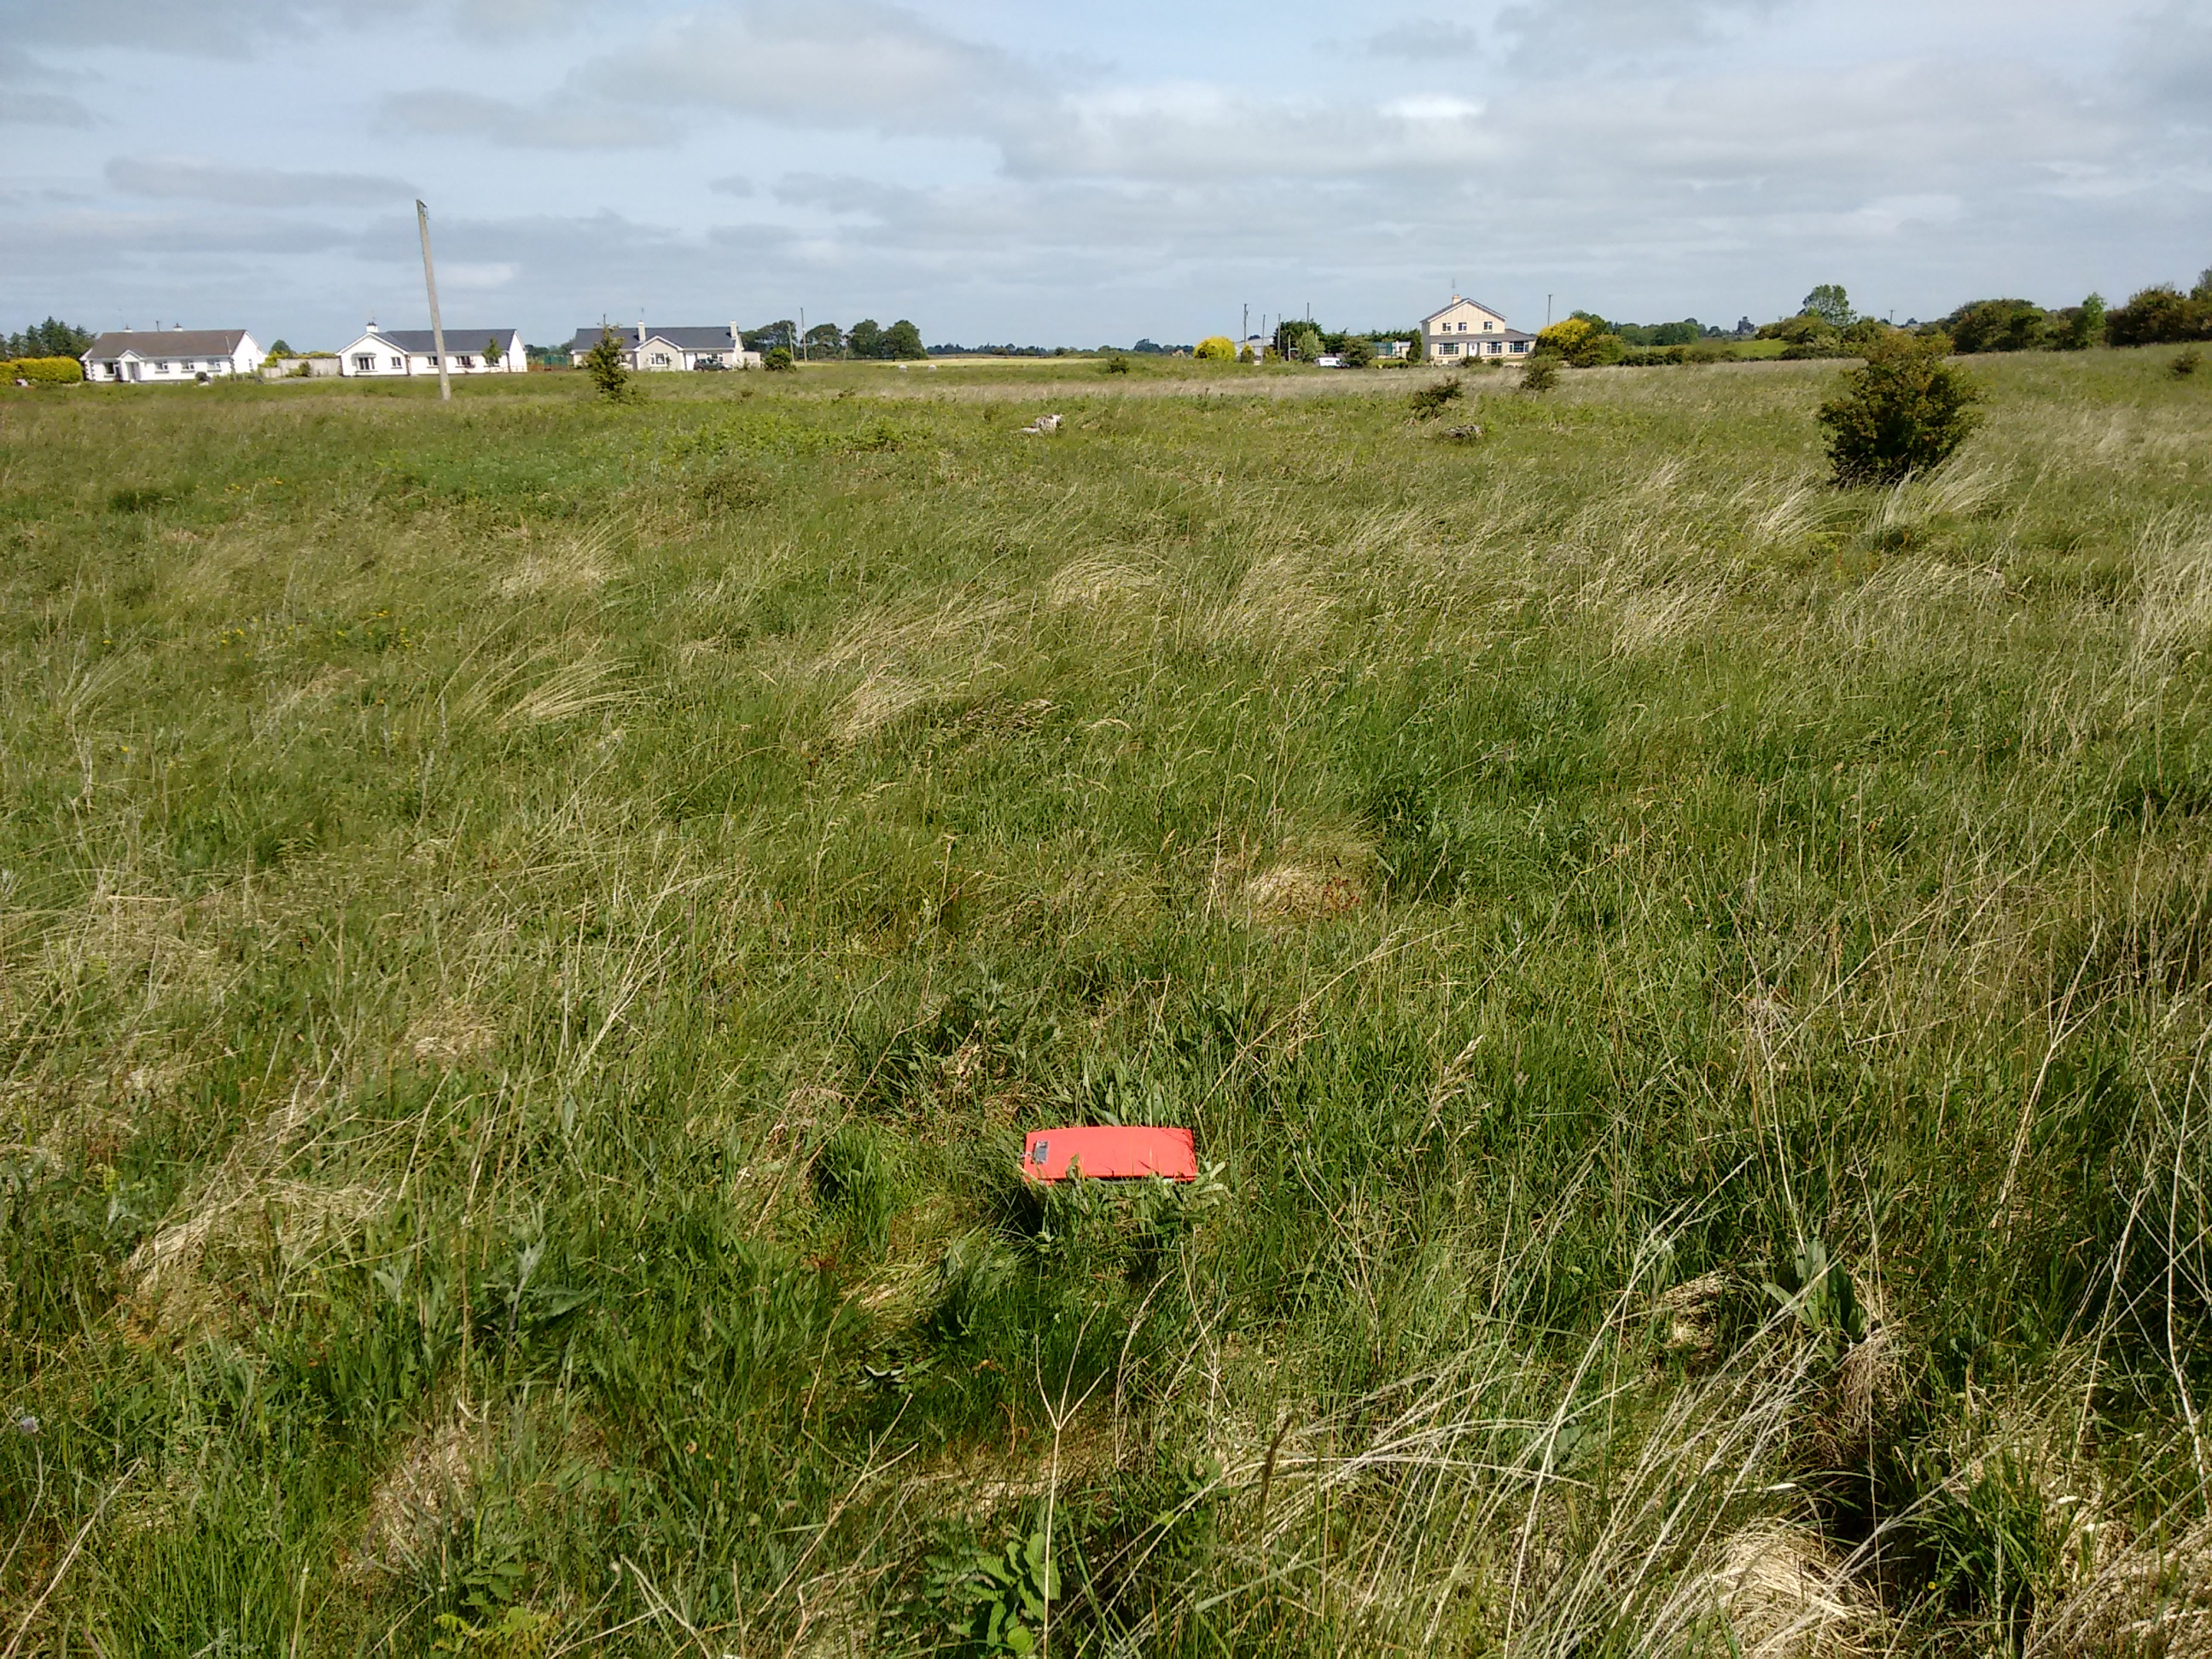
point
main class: Grassland
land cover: Grassland without tree/shrub cover
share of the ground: > 75 %
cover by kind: herbaceous plants 100 %
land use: Agriculture (excluding fallow land and kitchen gardens)
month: June
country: IE
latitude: 53.2258
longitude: -8.5444
